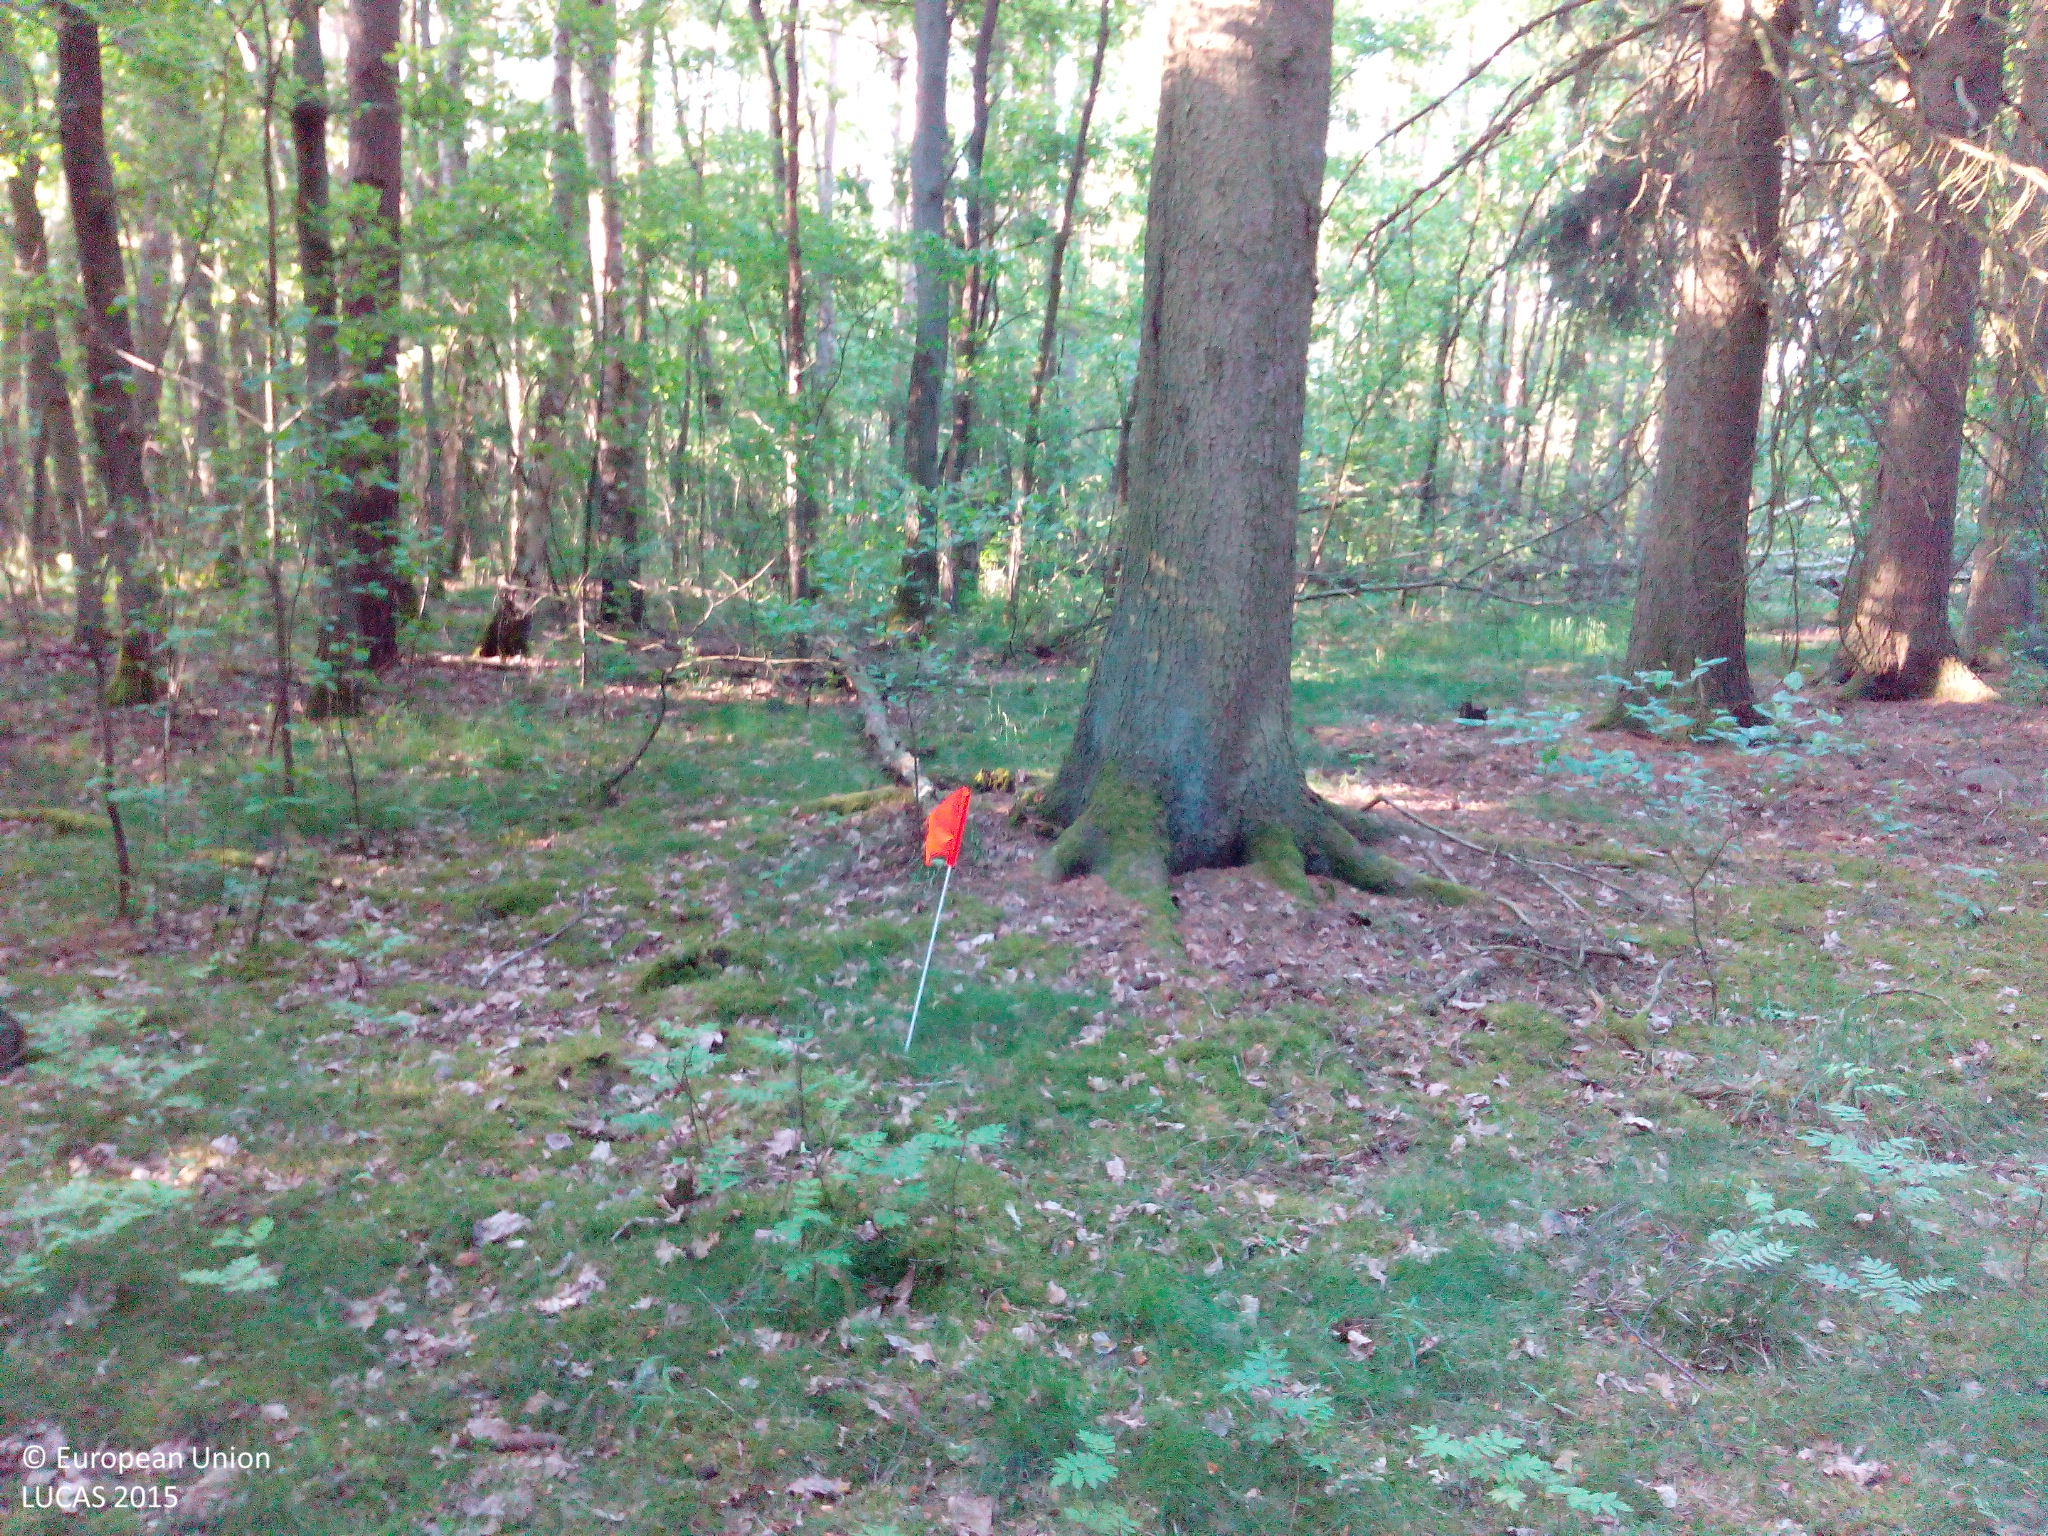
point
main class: Woodland
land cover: Pine dominated coniferous woodland
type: hemiboreal forest and nemoral coniferous forest and mixed broadleaved-coniferous forest
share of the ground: 50 - 75 %
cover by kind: coniferous forest trees 50 %, broadleaved forest trees 15 %, herbaceous plants 15 %, lichens and mosses 10 %, shrubs 5 %, unconsolidated bare surface 5 %
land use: Forestry
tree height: > 5 m
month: June
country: DE
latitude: 53.2353
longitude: 12.3516
